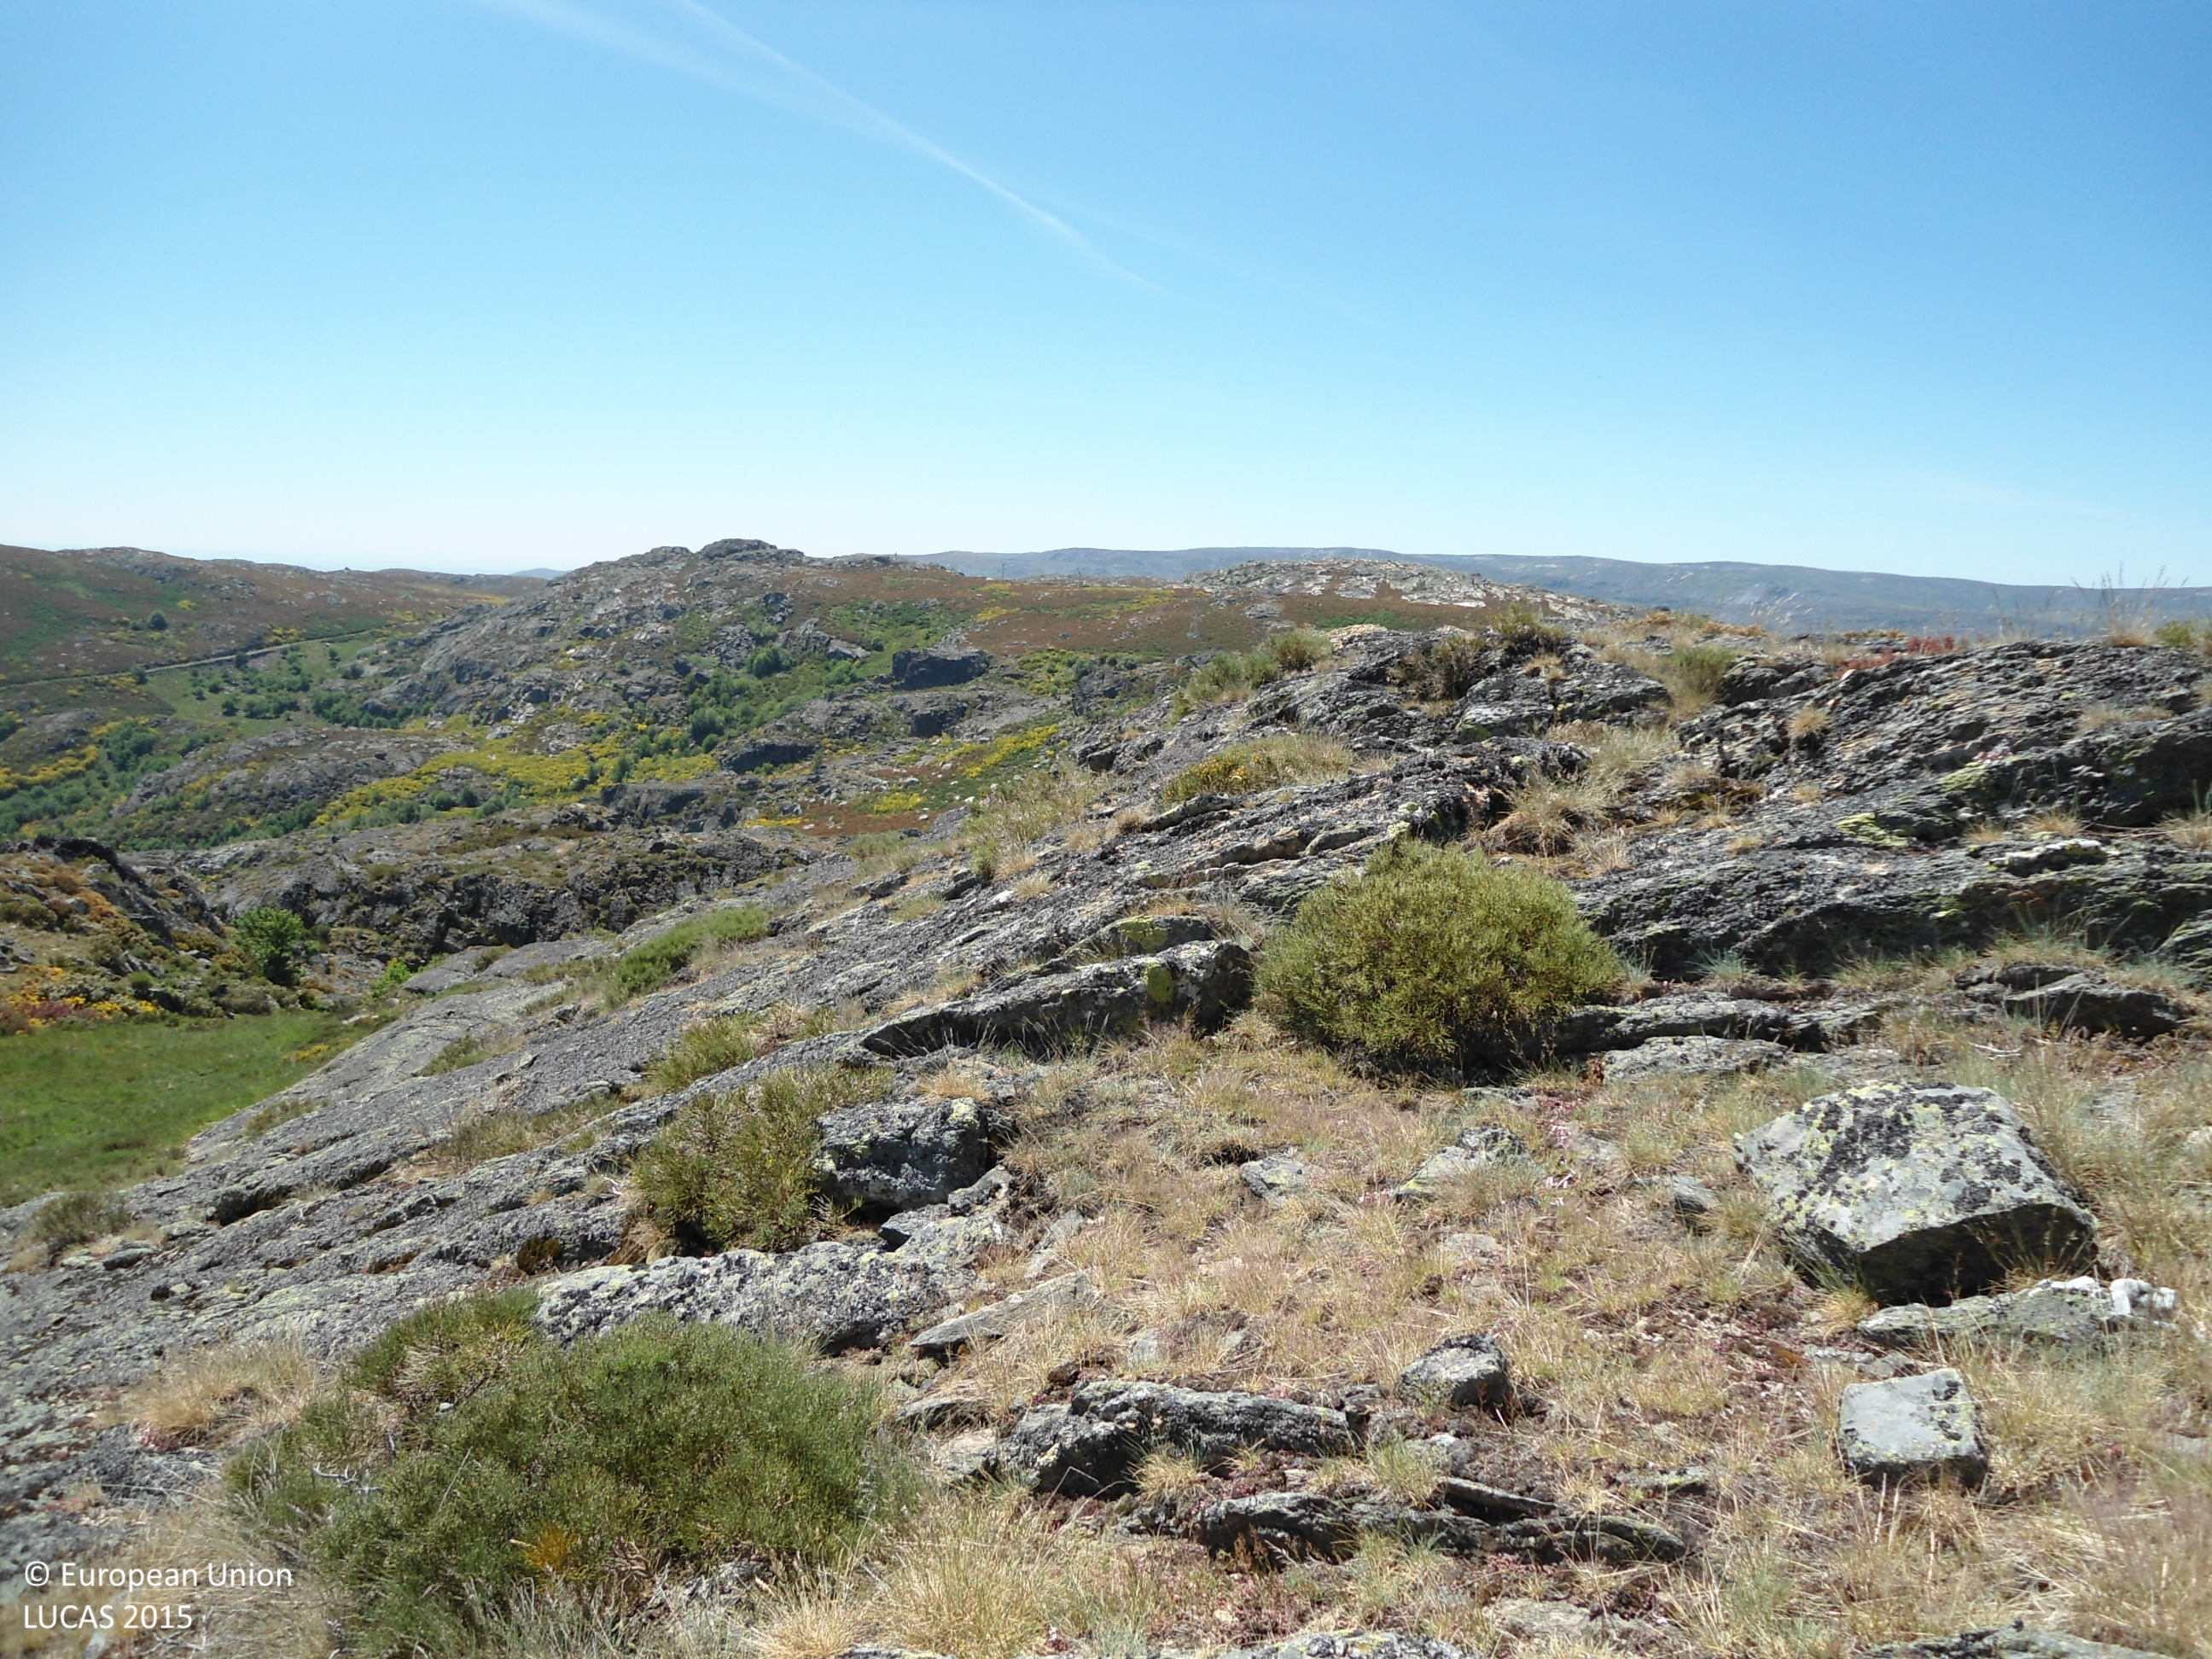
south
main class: Shrubland
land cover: Shrubland without tree cover
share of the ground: > 75 %
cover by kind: shrubs 90 %, consolidated bare surface 10 %
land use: Community services
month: June
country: ES
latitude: 42.1618
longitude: -6.7854
